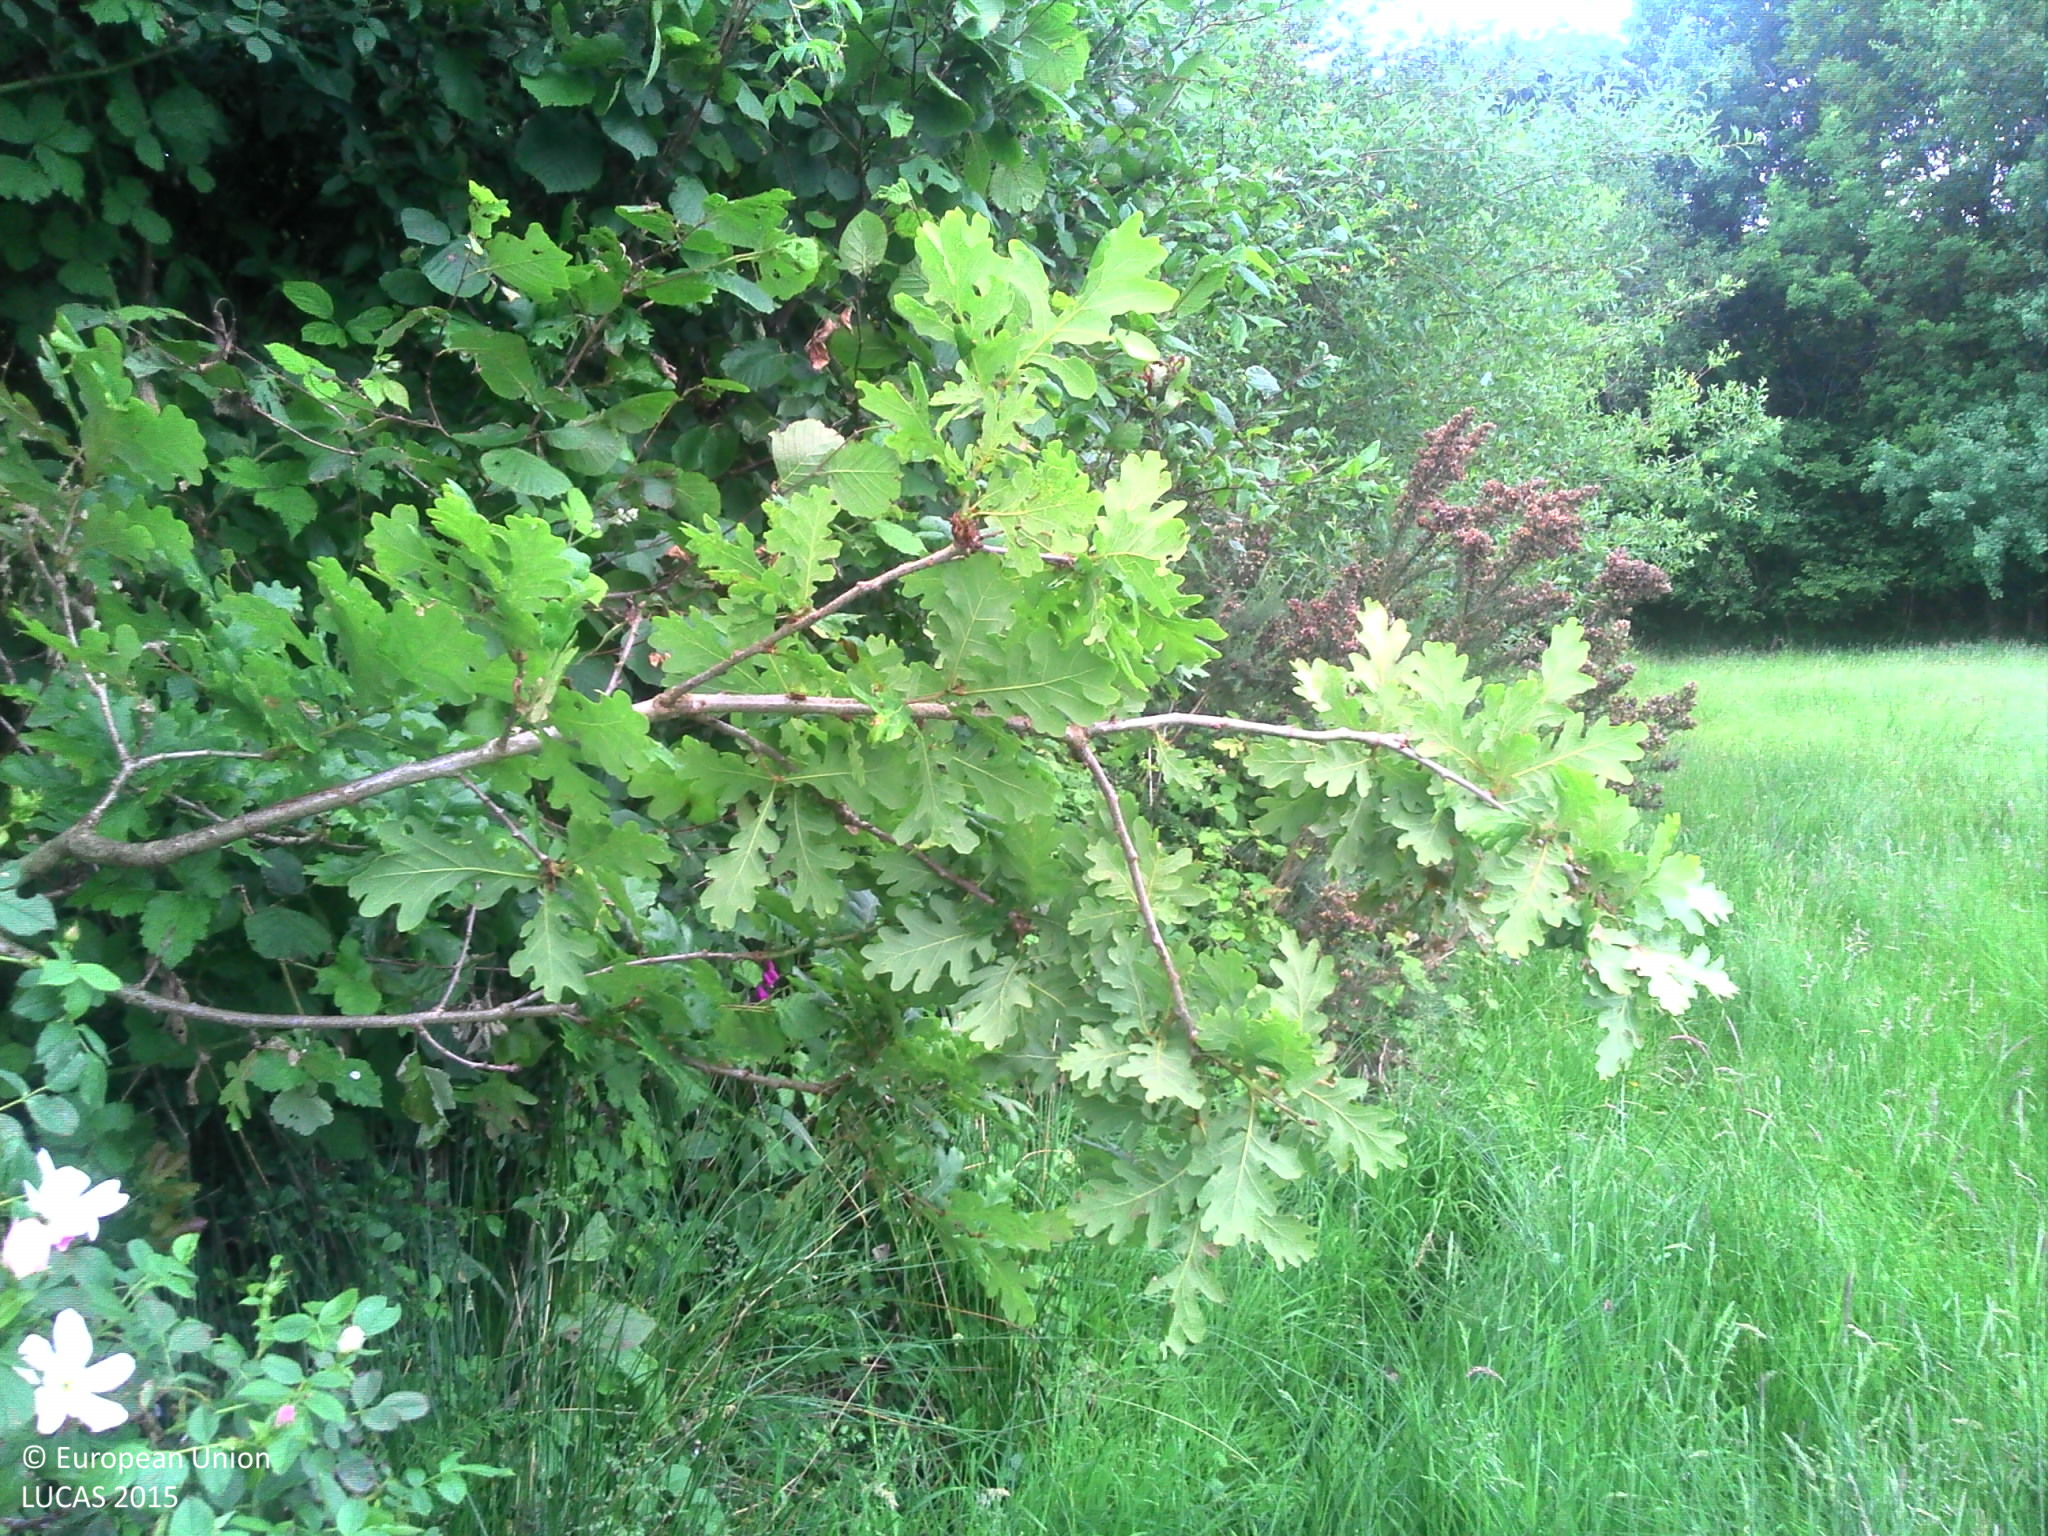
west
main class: Grassland
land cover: Grassland without tree/shrub cover
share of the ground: > 75 %
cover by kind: herbaceous plants 100 %
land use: Agriculture (excluding fallow land and kitchen gardens)
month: June
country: FR
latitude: 49.3982
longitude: -1.6955
